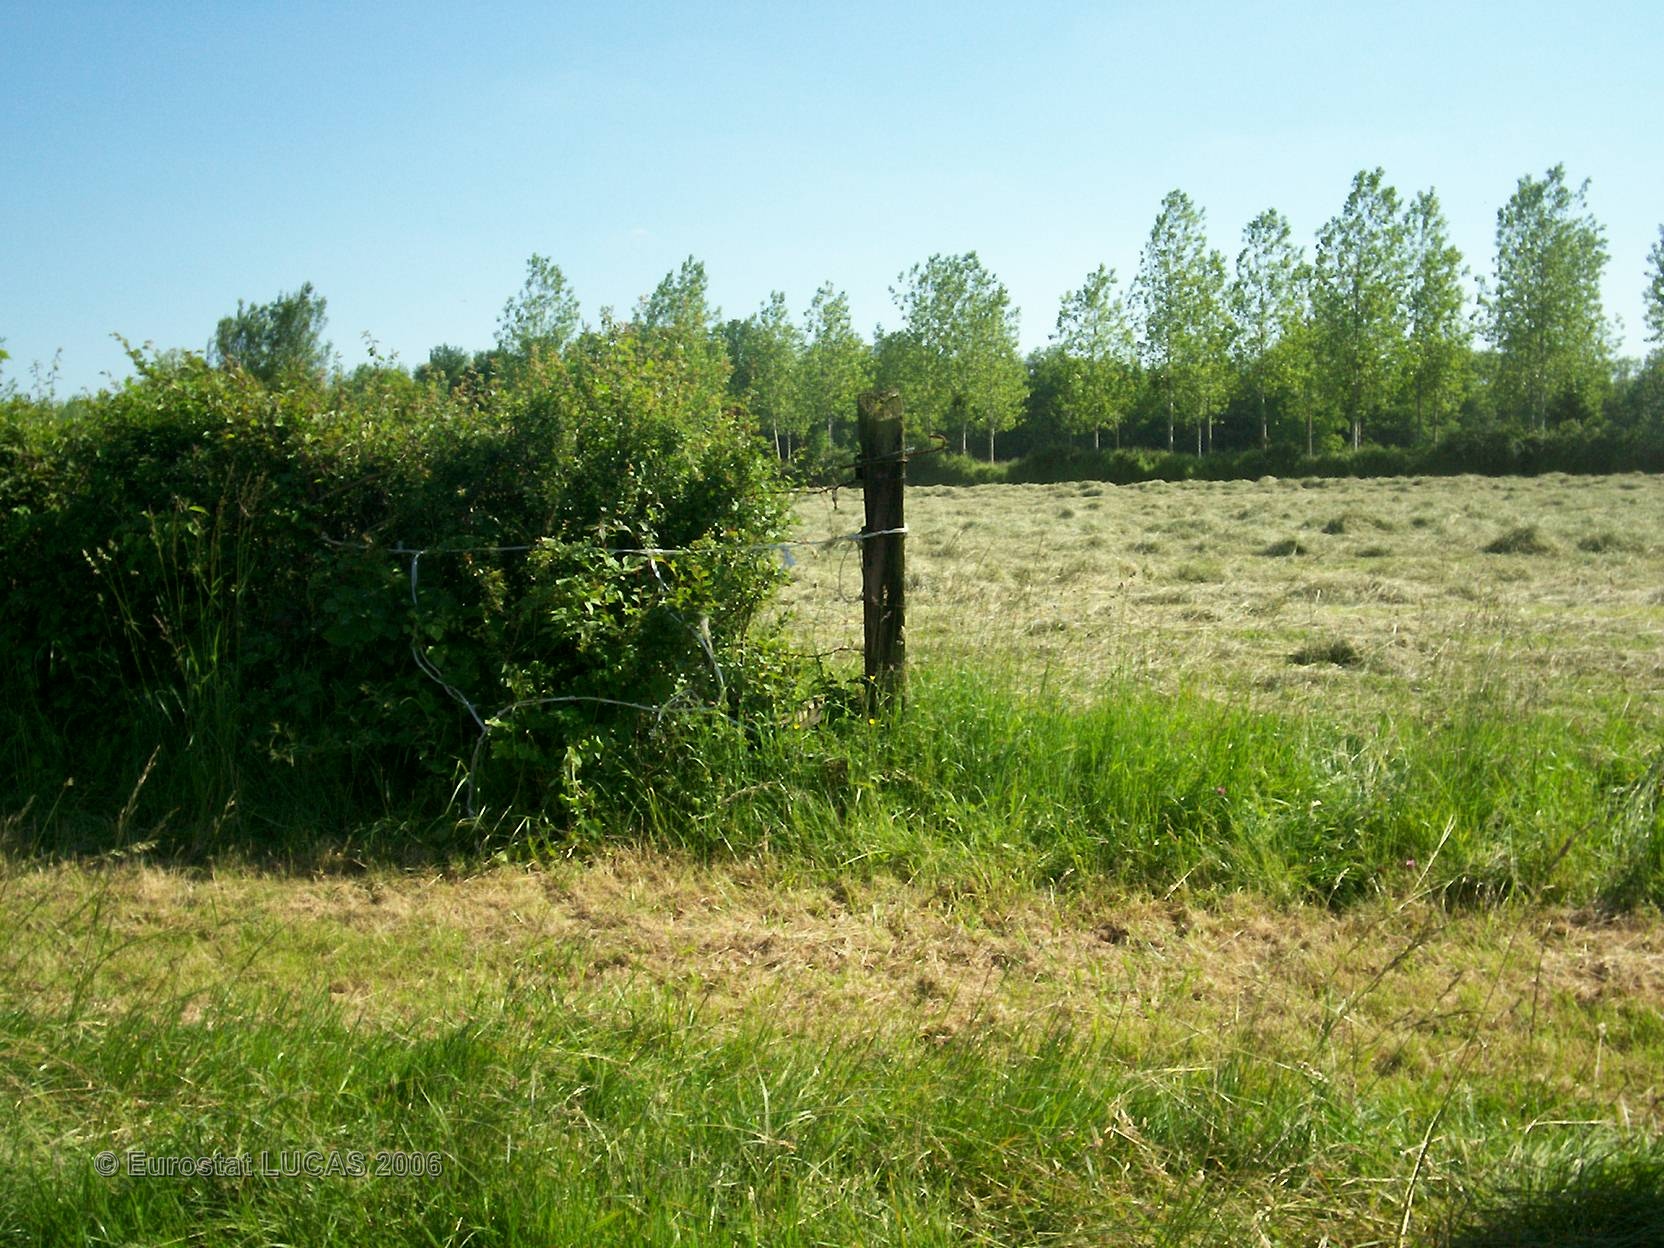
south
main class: Grassland
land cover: Grassland without tree/shrub cover
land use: Agriculture (excluding fallow land and kitchen gardens)
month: June
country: FR
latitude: 48.7416
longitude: 4.6258
